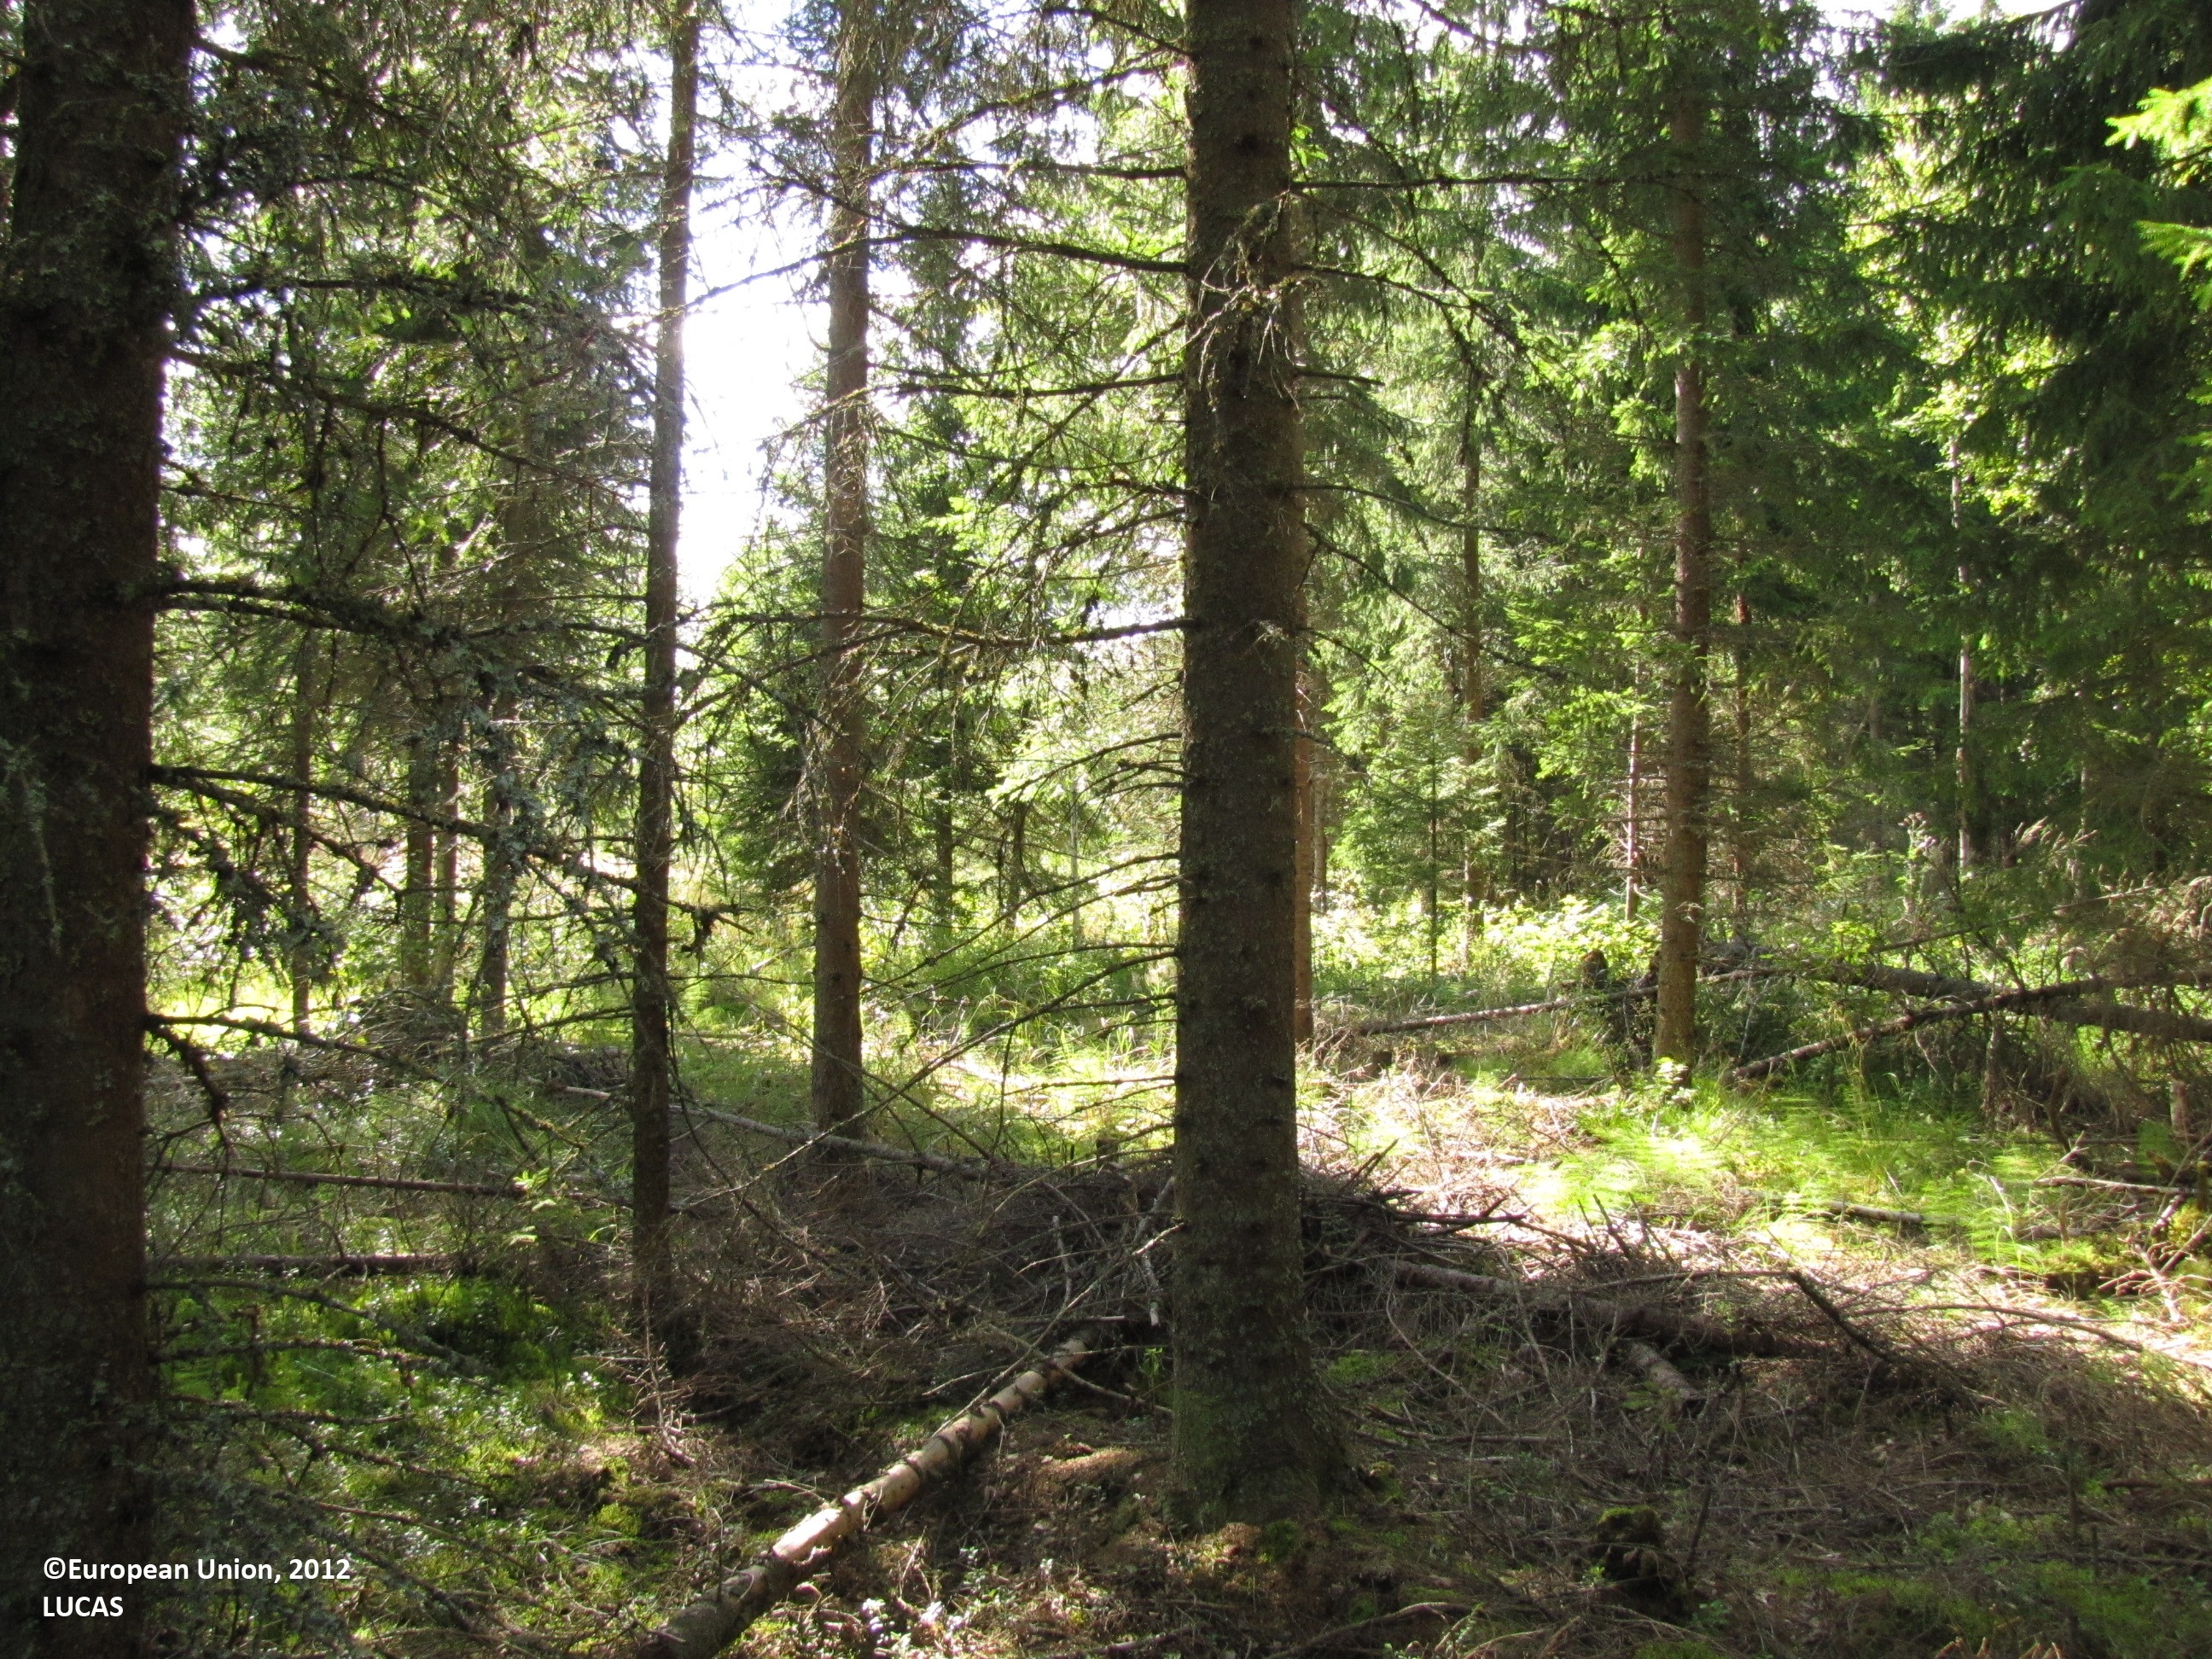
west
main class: Woodland
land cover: Spruce dominated mixed woodland
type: boreal forest
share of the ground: 50 - 75 %
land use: Forestry
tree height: > 5 m
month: August
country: FI
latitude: 61.7622
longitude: 22.8940
